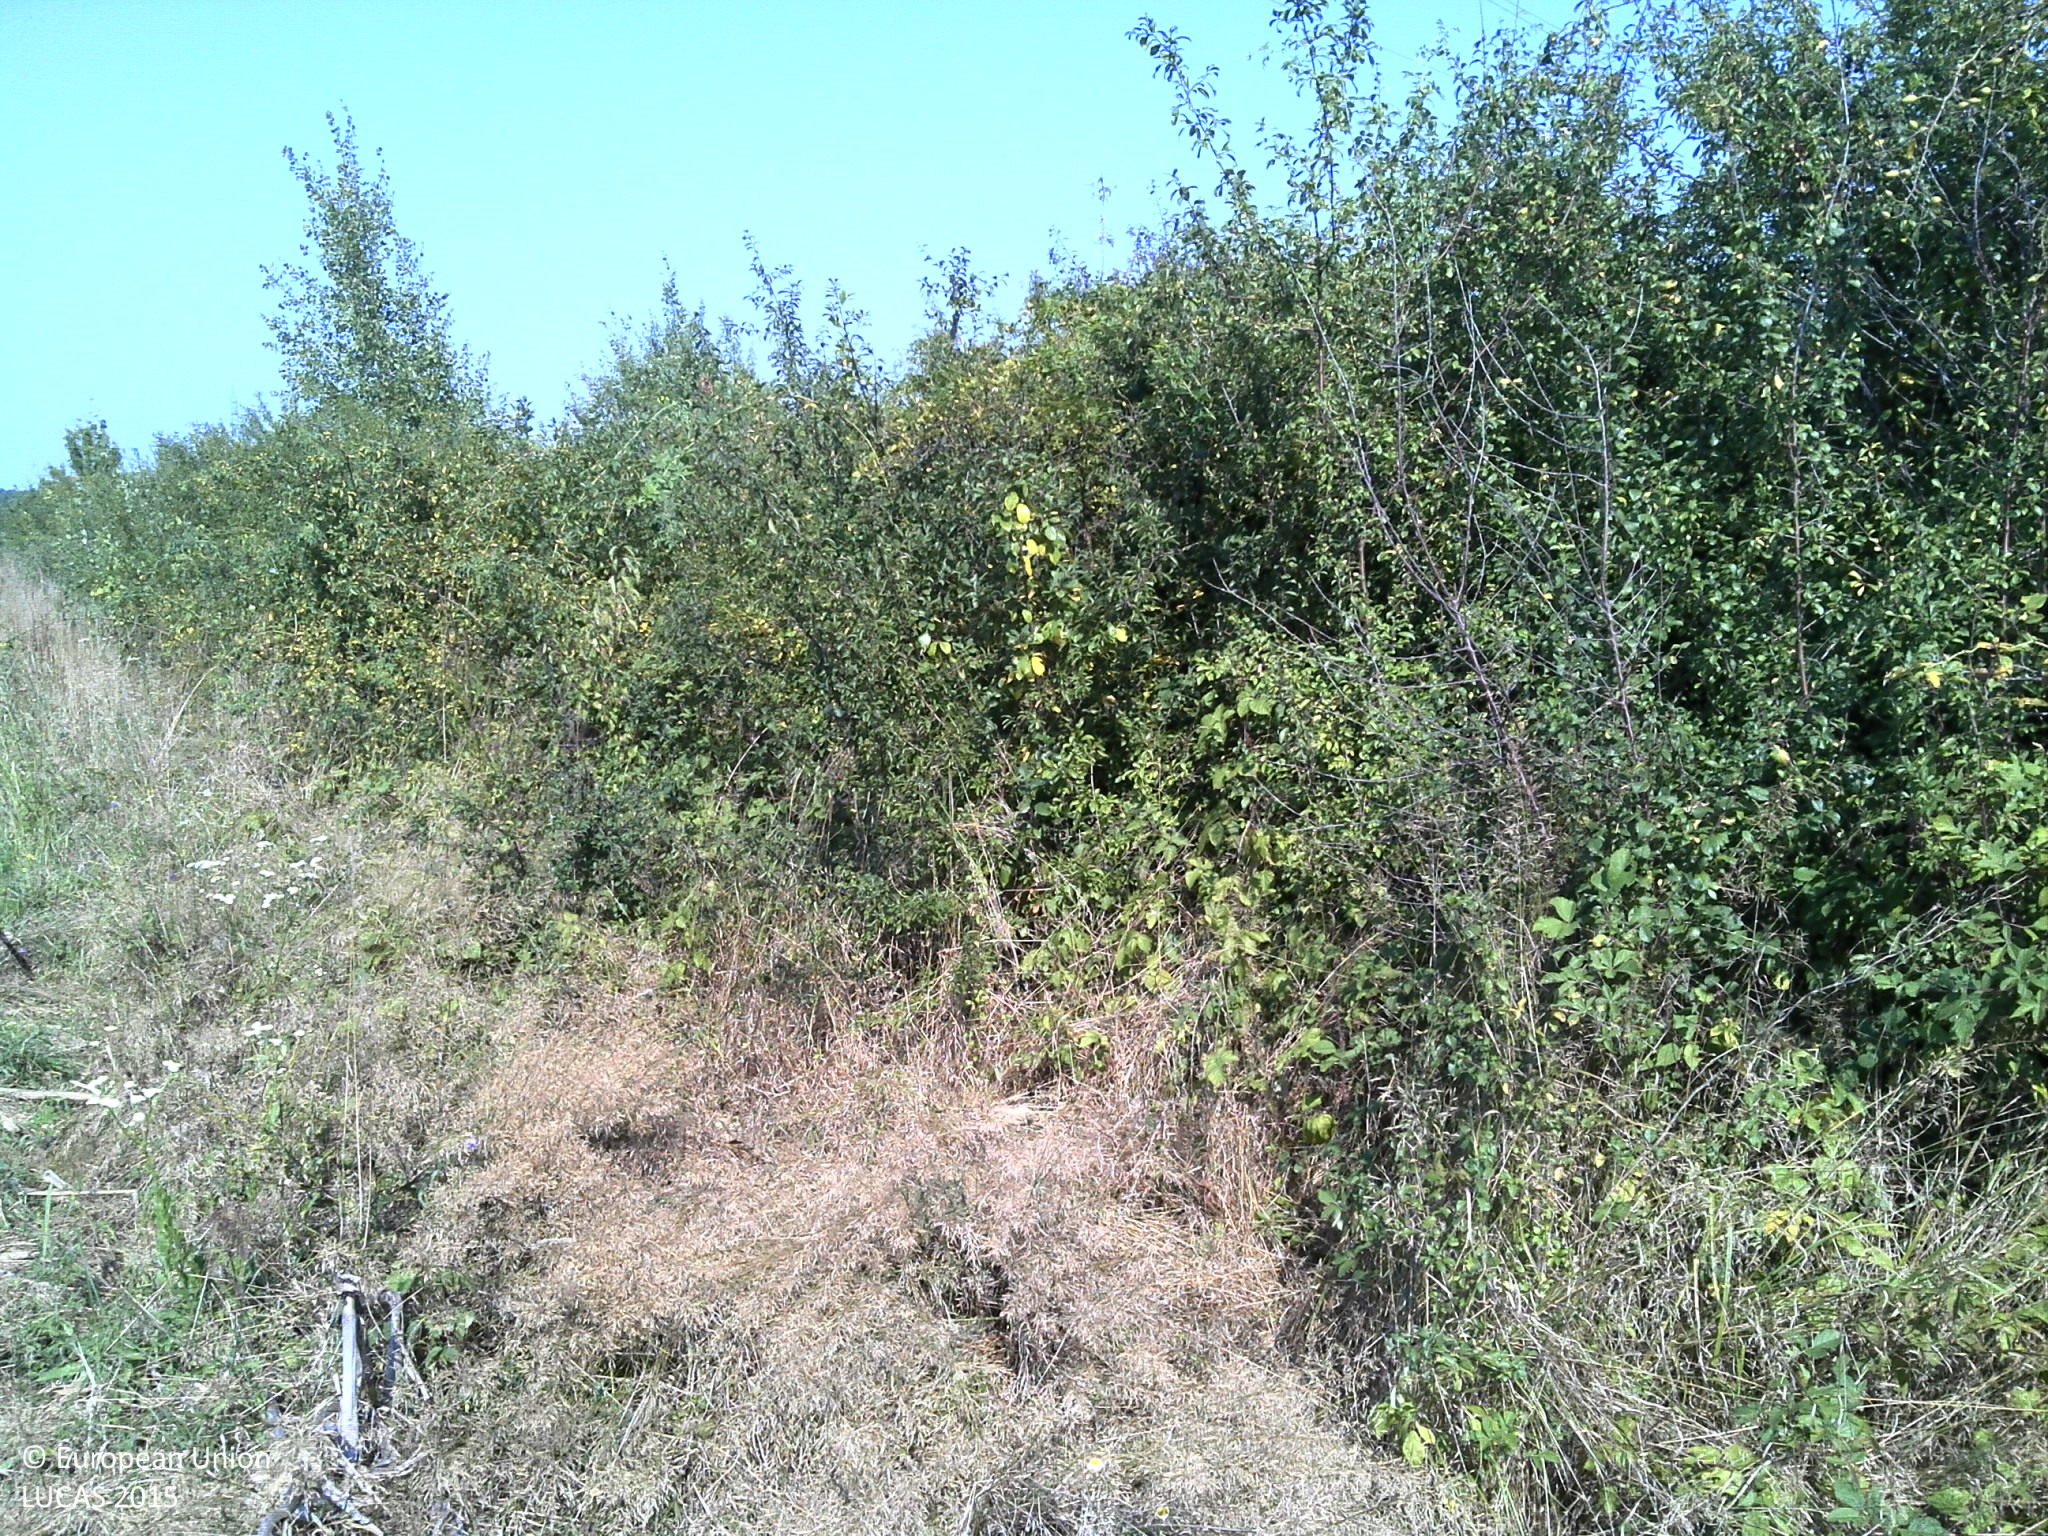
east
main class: Grassland
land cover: Spontaneously vegetated surfaces
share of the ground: > 75 %
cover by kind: herbaceous plants 80 %
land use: Fallow land
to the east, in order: Spontaneously vegetated surfaces; Shrubland without tree cover; Electric lines; Other bare soil; Maize; Shrubland with sparse tree cover; Spontaneously vegetated surfaces; Grassland without tree/shrub cover
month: August
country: HR
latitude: 45.5355
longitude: 16.2597
